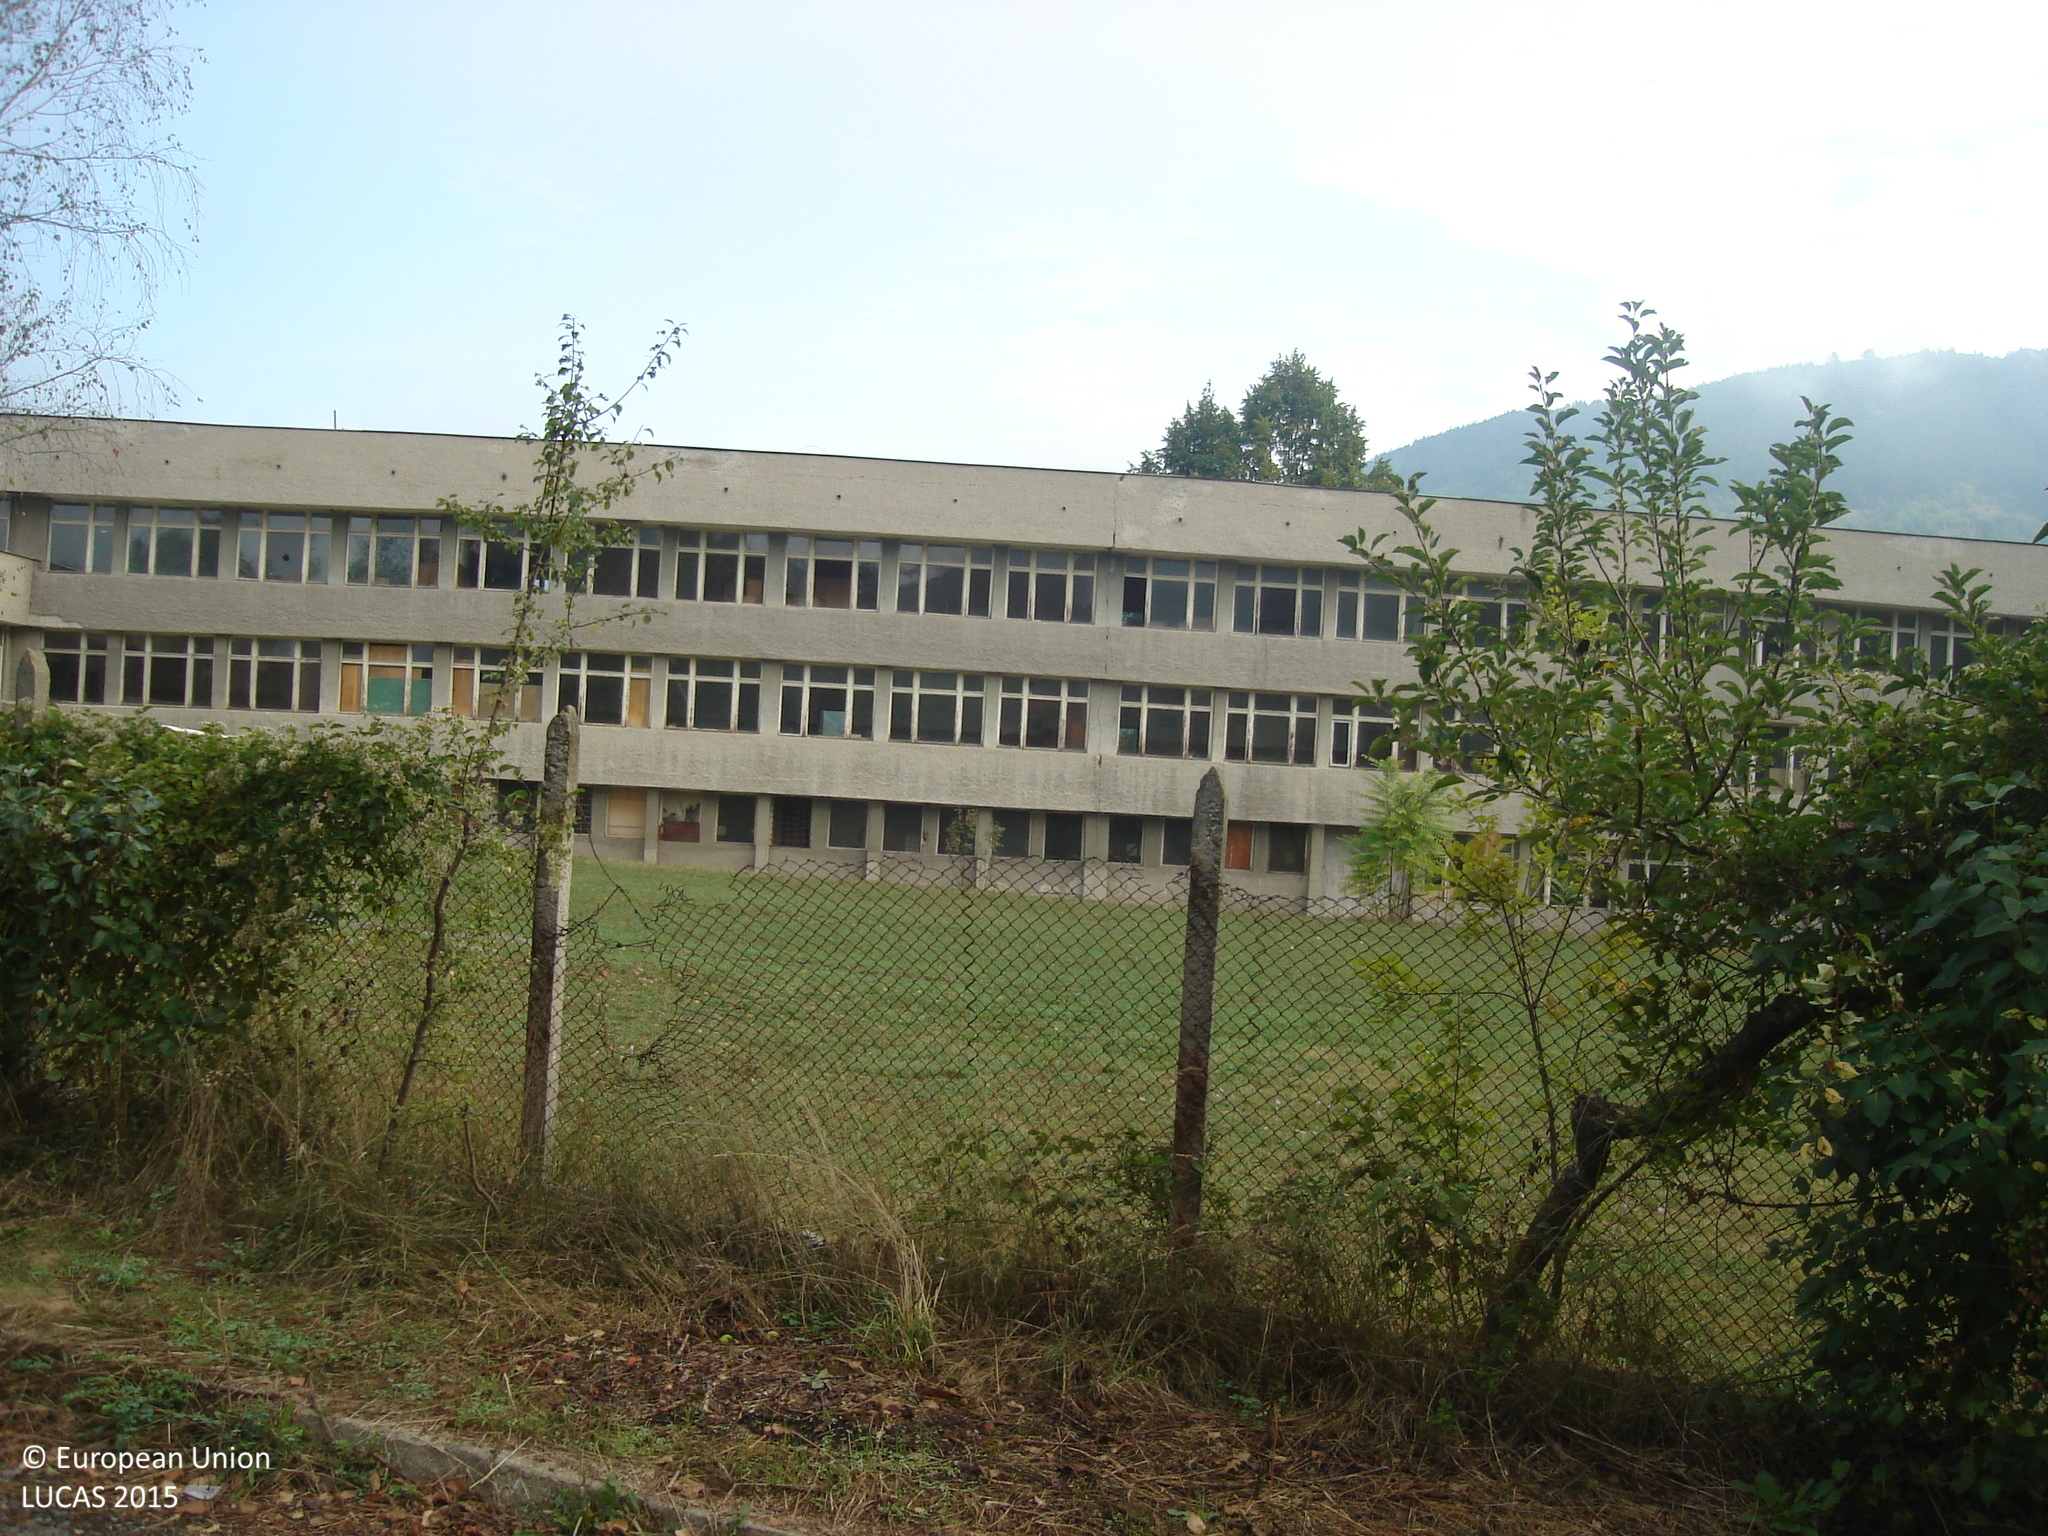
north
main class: Woodland
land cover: Broadleaved woodland
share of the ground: > 75 %
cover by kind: broadleaved forest trees 80 %
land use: Residential
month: September
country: BG
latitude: 42.9314
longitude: 23.3811
